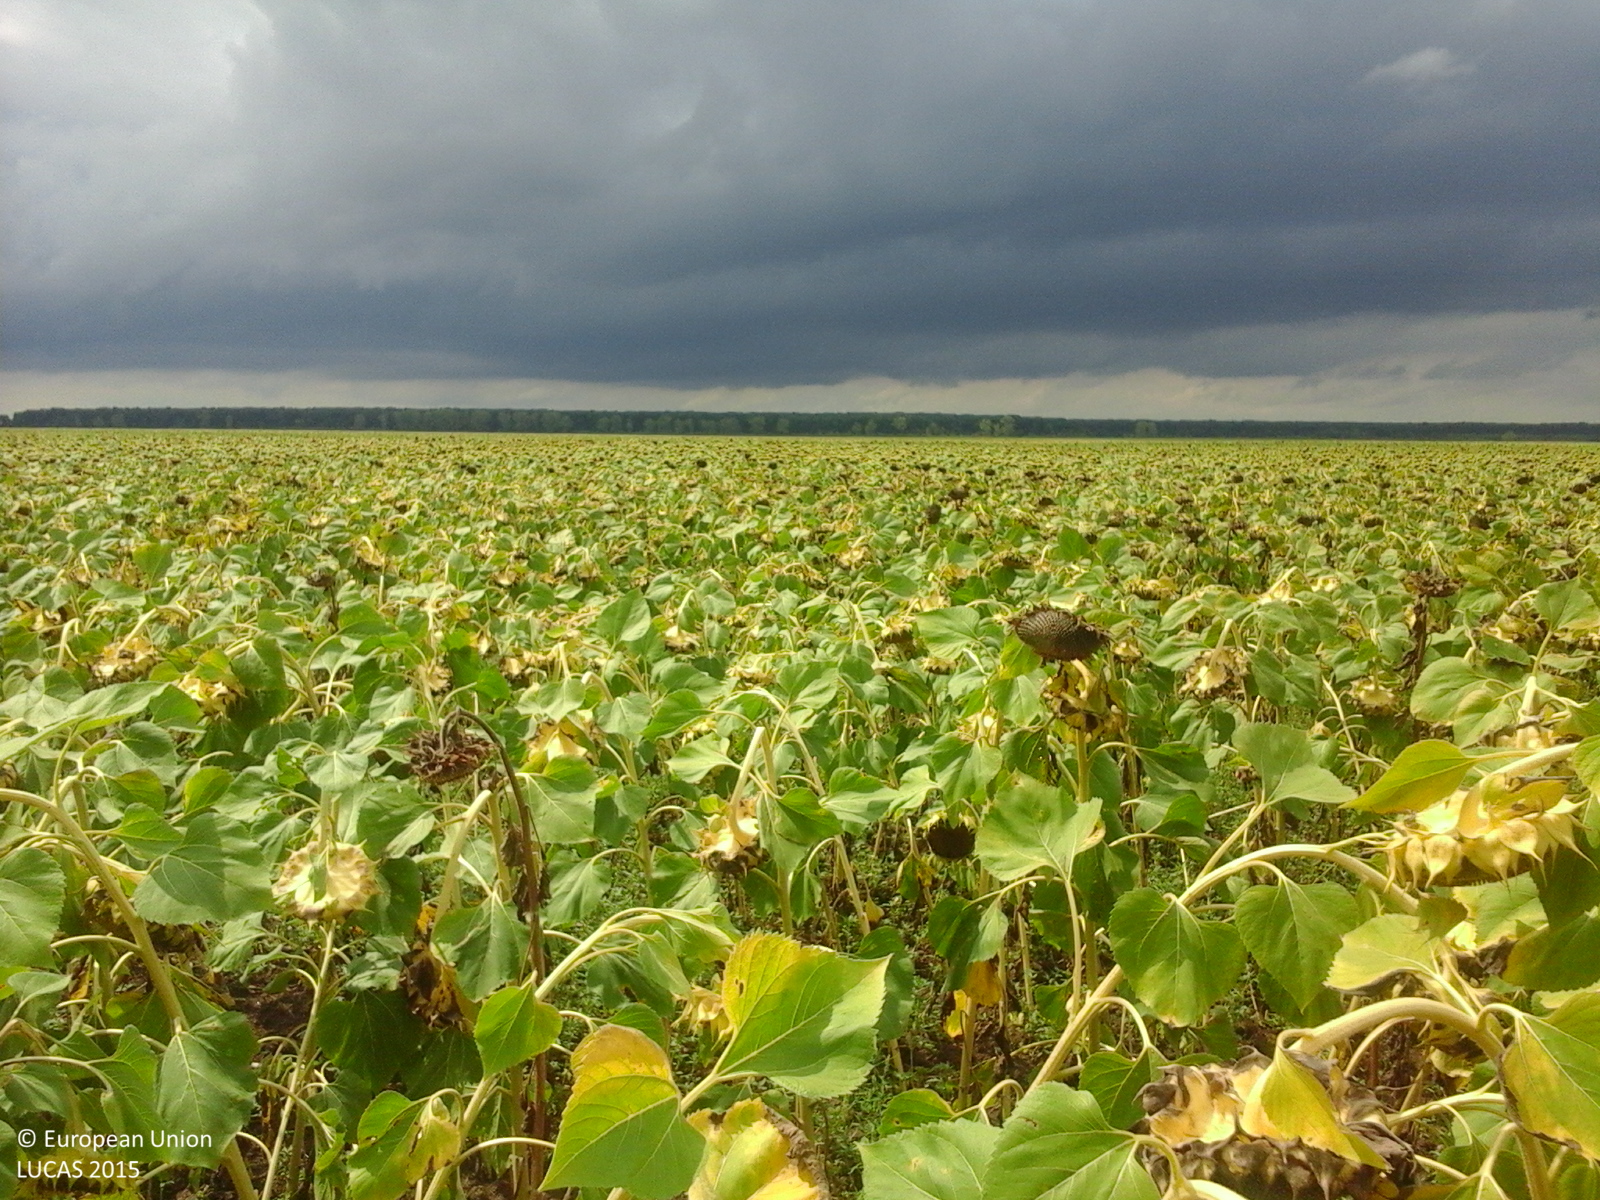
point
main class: Cropland
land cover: Sunflower
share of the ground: > 75 %
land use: Agriculture (excluding fallow land and kitchen gardens)
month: August
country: RO
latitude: 45.6839
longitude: 21.5770
